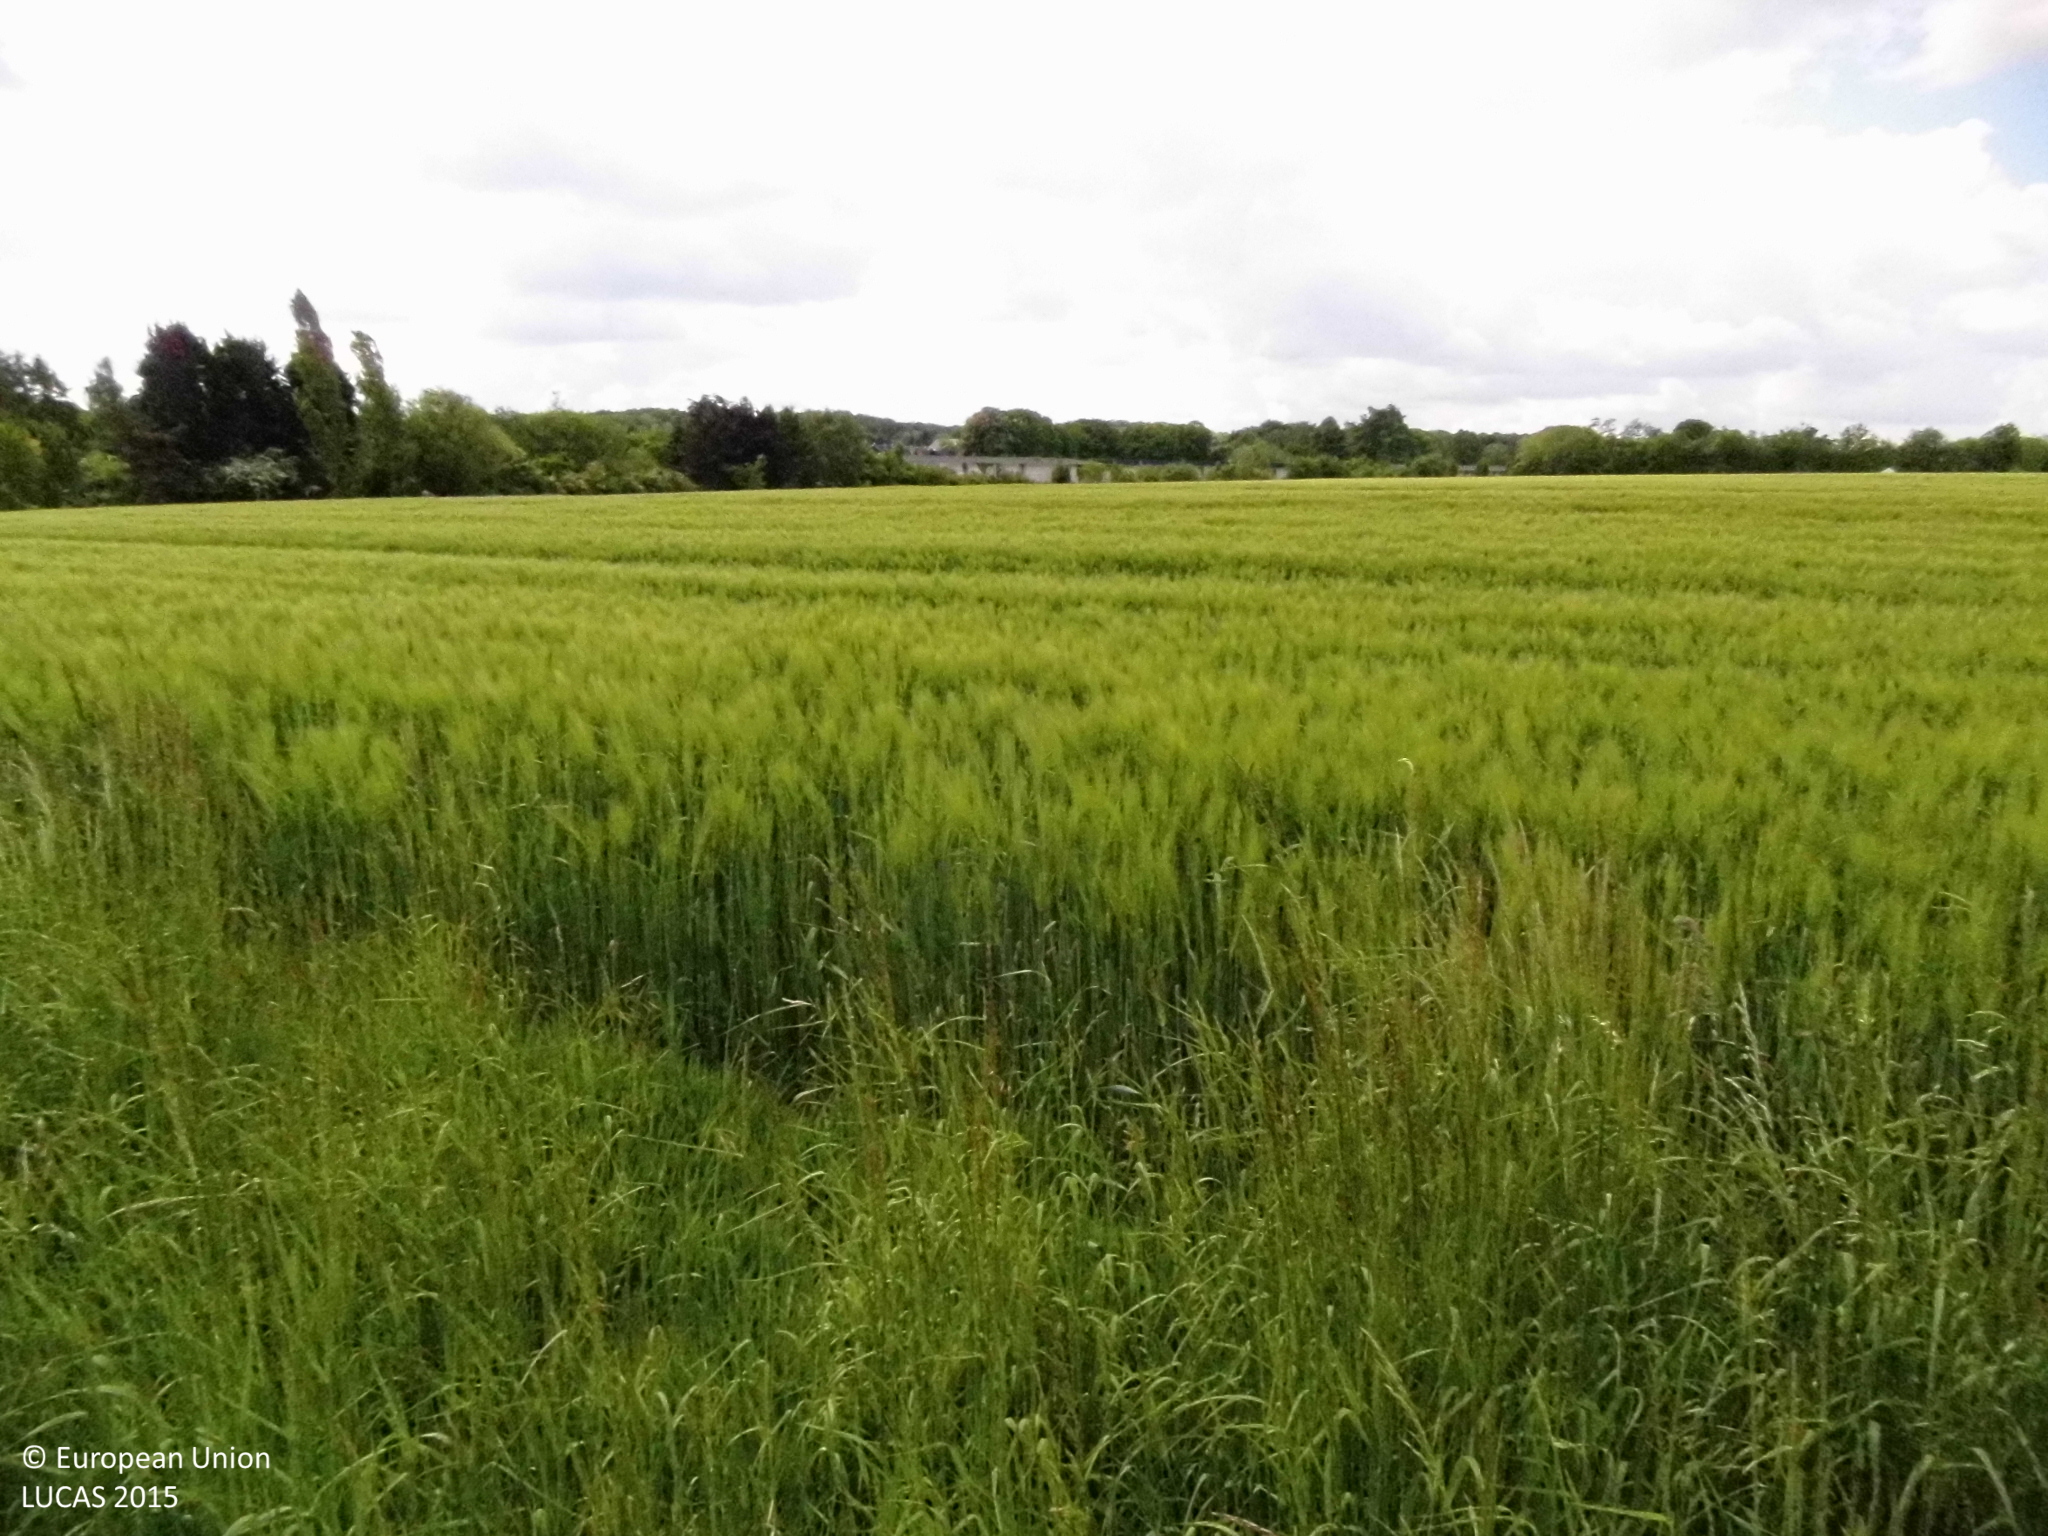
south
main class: Grassland
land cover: Spontaneously vegetated surfaces
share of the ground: > 75 %
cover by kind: herbaceous plants 100 %
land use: Semi-natural and natural areas not in use
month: May
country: DE
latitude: 51.5773
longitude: 7.4750
